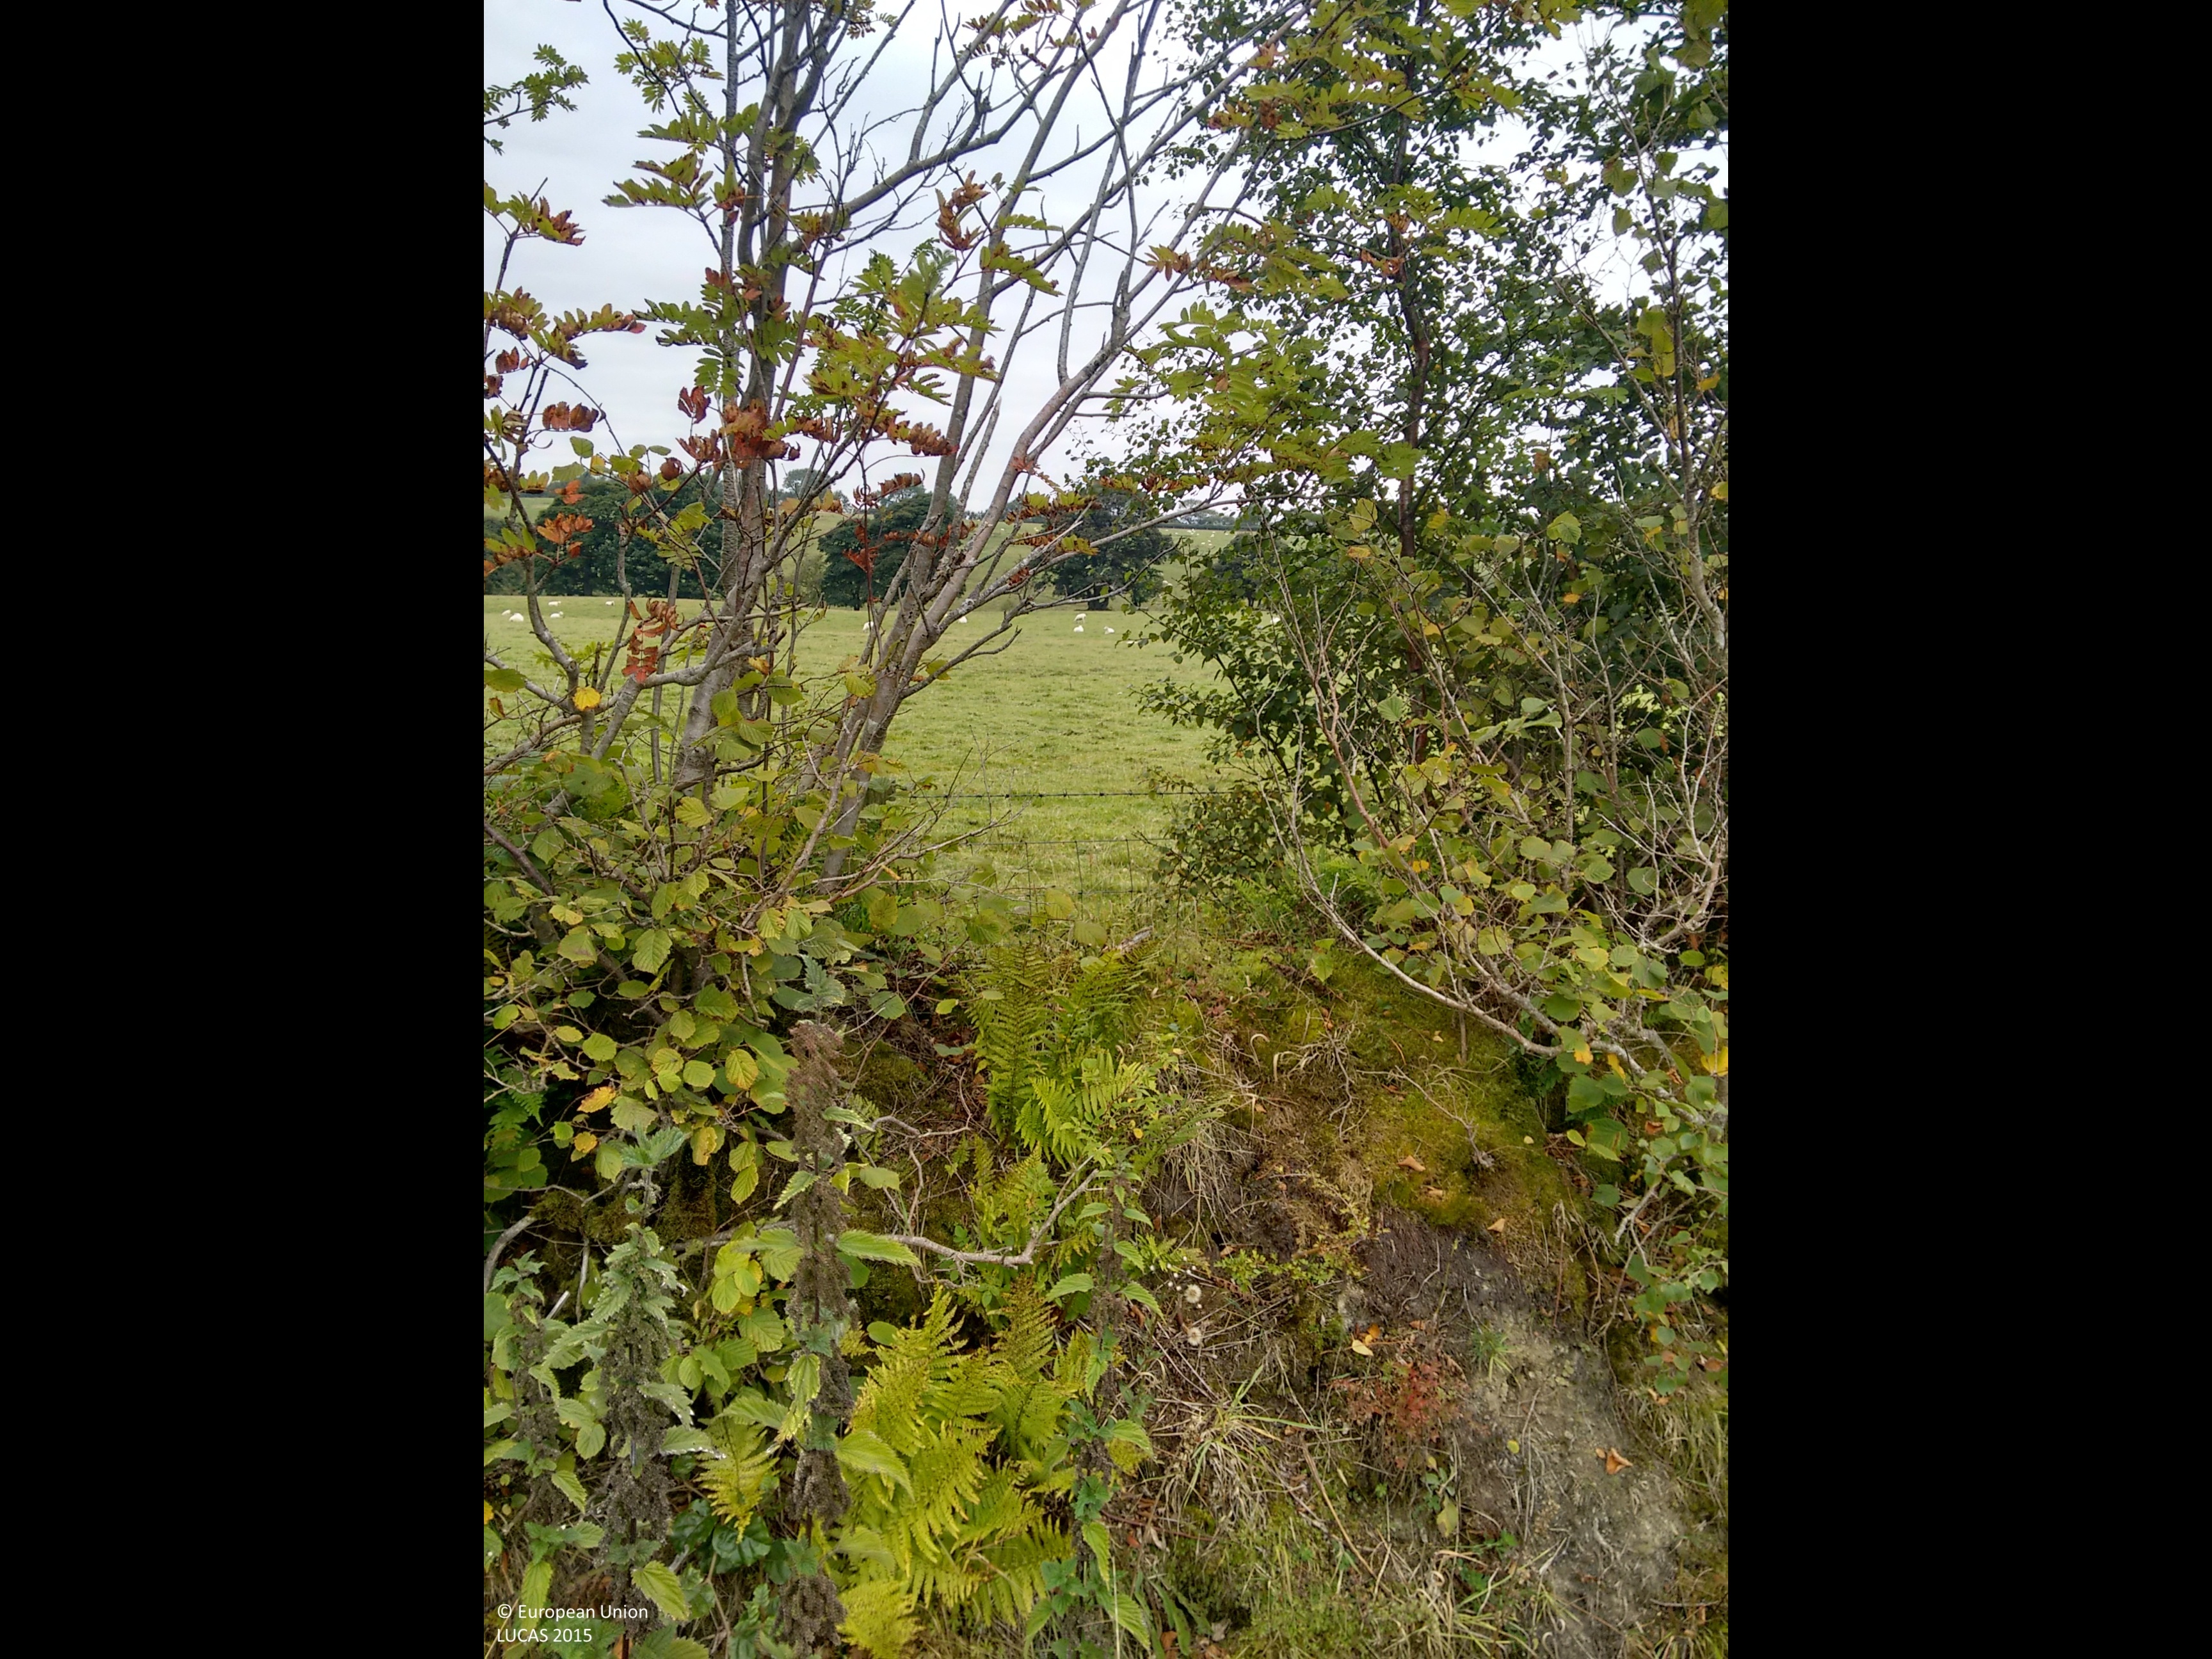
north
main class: Grassland
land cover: Grassland without tree/shrub cover
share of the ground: > 75 %
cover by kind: herbaceous plants 100 %
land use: Agriculture (excluding fallow land and kitchen gardens)
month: September
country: GB
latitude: 53.0346
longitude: -3.2470
